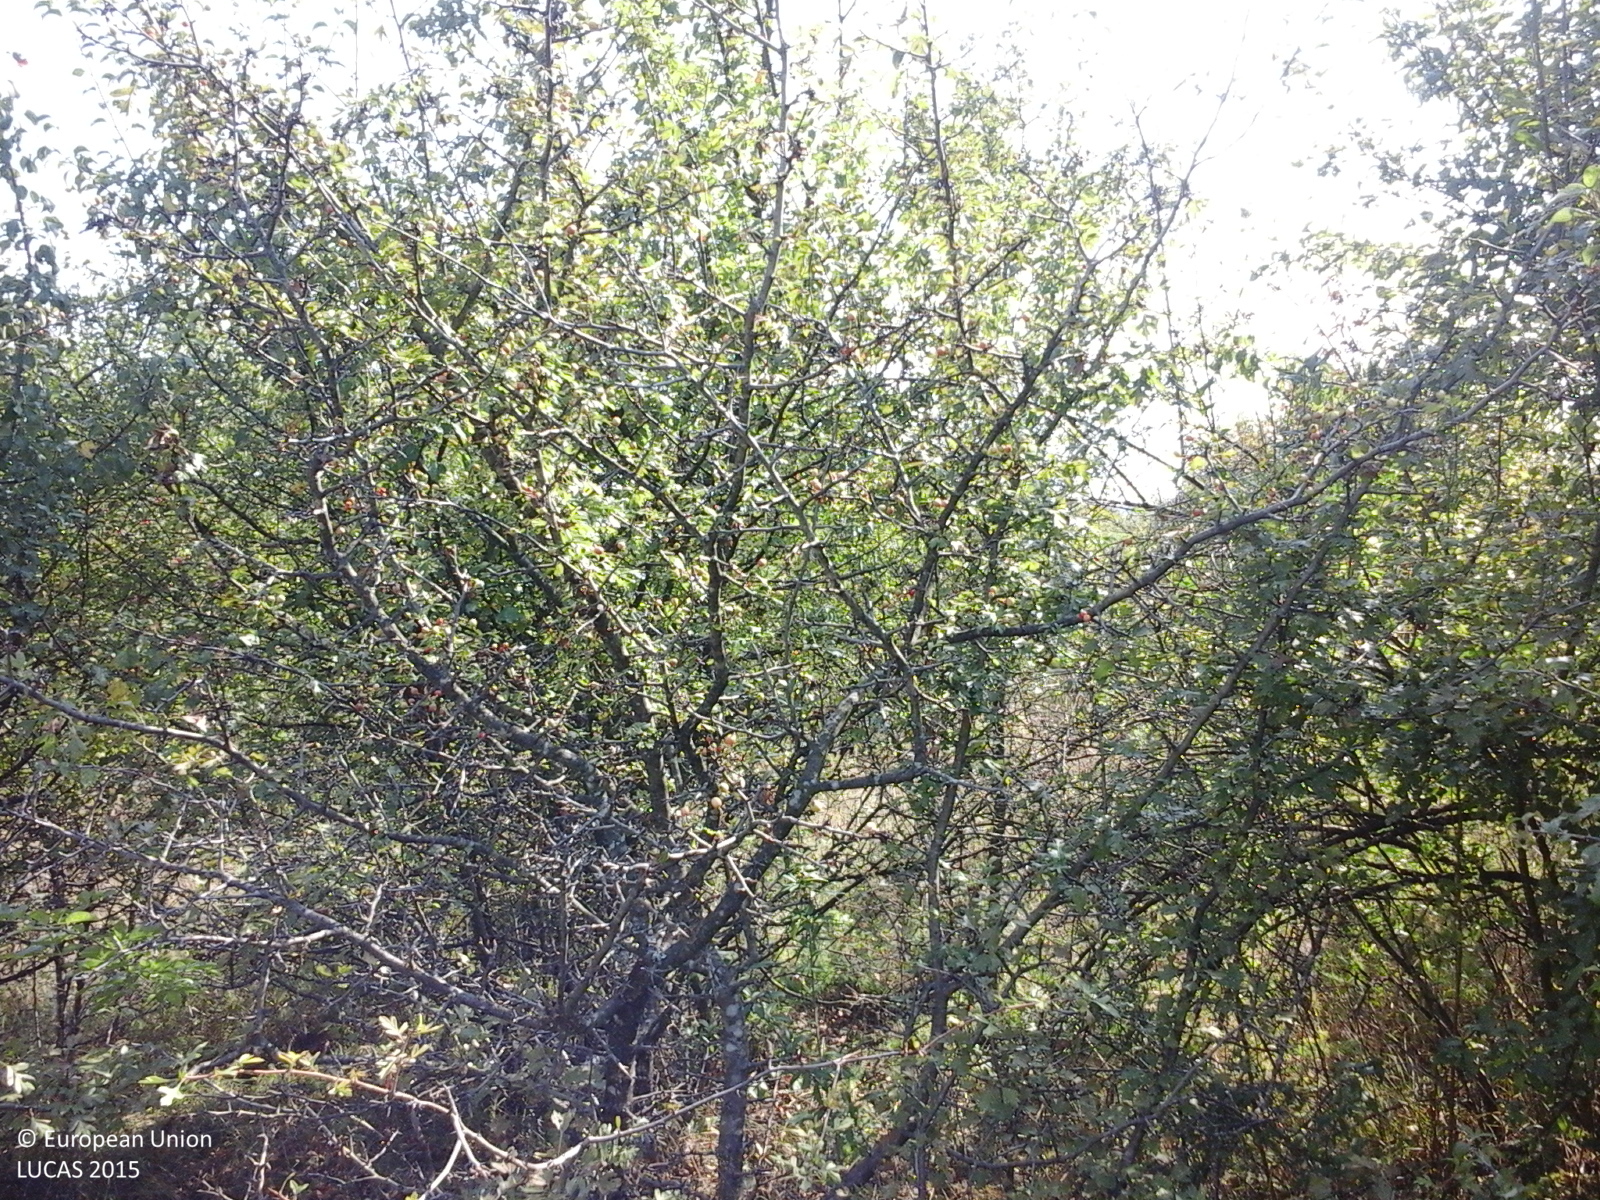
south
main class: Shrubland
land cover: Shrubland without tree cover
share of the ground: > 75 %
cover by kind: shrubs 100 %
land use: Semi-natural and natural areas not in use
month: September
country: RO
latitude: 47.1299
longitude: 24.2309
